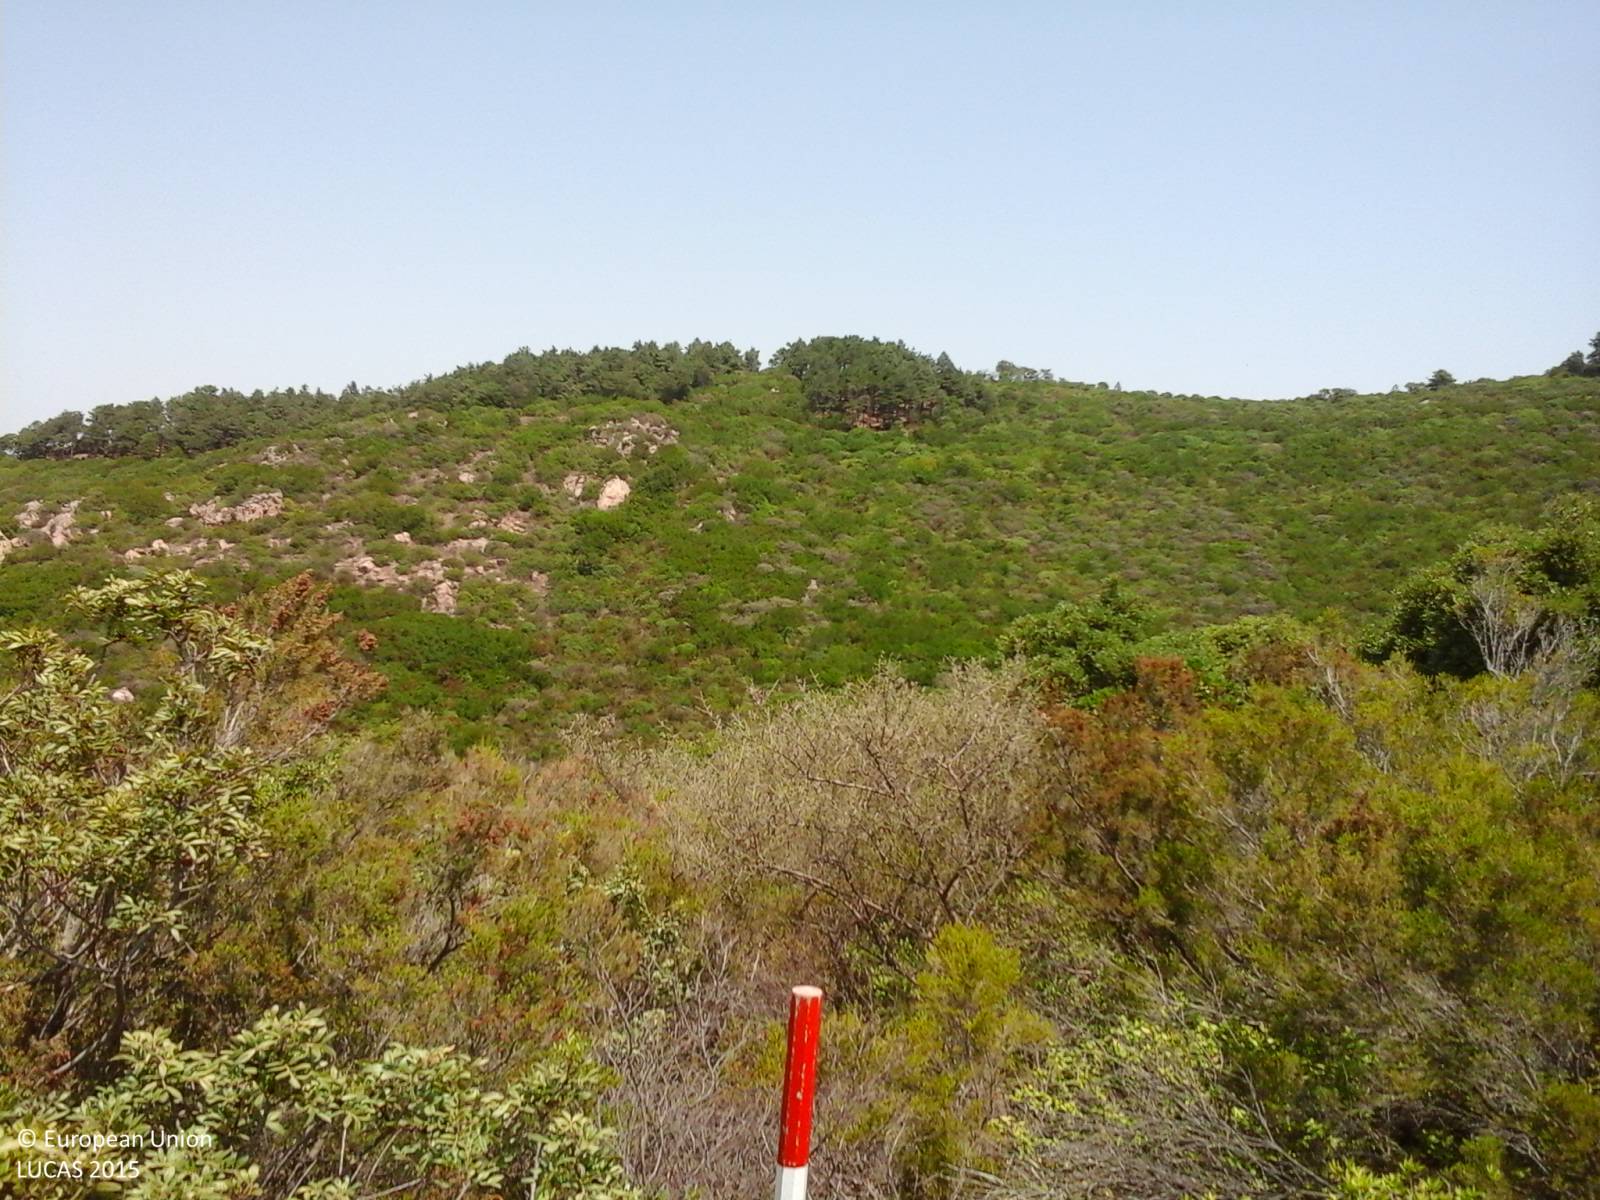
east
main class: Shrubland
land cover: Shrubland with sparse tree cover
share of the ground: > 75 %
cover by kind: shrubs 95 %, broadleaved forest trees 5 %
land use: Semi-natural and natural areas not in use
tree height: < 5 m
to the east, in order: Shrubland with sparse tree cover; Tracks; Shrubland with sparse tree cover
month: July
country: IT
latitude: 39.9522
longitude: 8.8010
